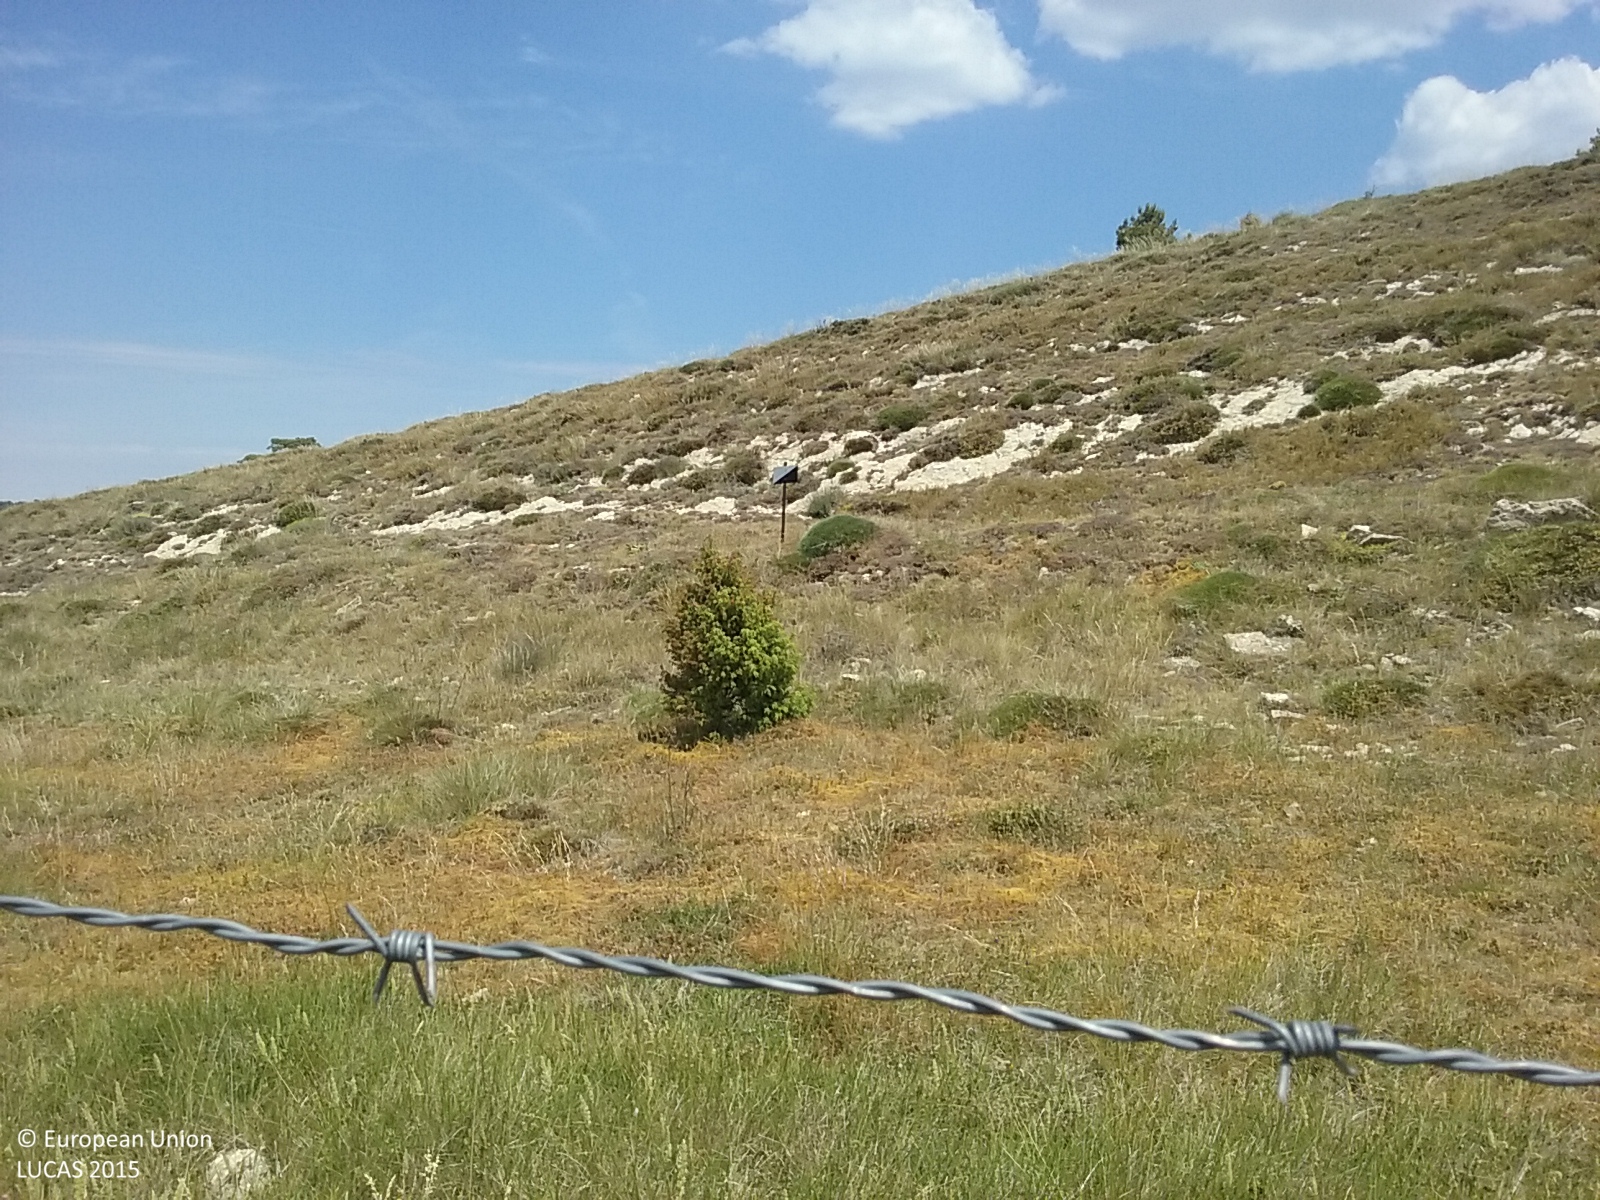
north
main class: Shrubland
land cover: Shrubland with sparse tree cover
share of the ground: 25 - 50 %
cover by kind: unconsolidated bare surface 65 %, shrubs 20 %, herbaceous plants 10 %, coniferous forest trees 5 %
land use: Semi-natural and natural areas not in use
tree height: < 5 m
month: June
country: ES
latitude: 40.6501
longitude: 0.0236
